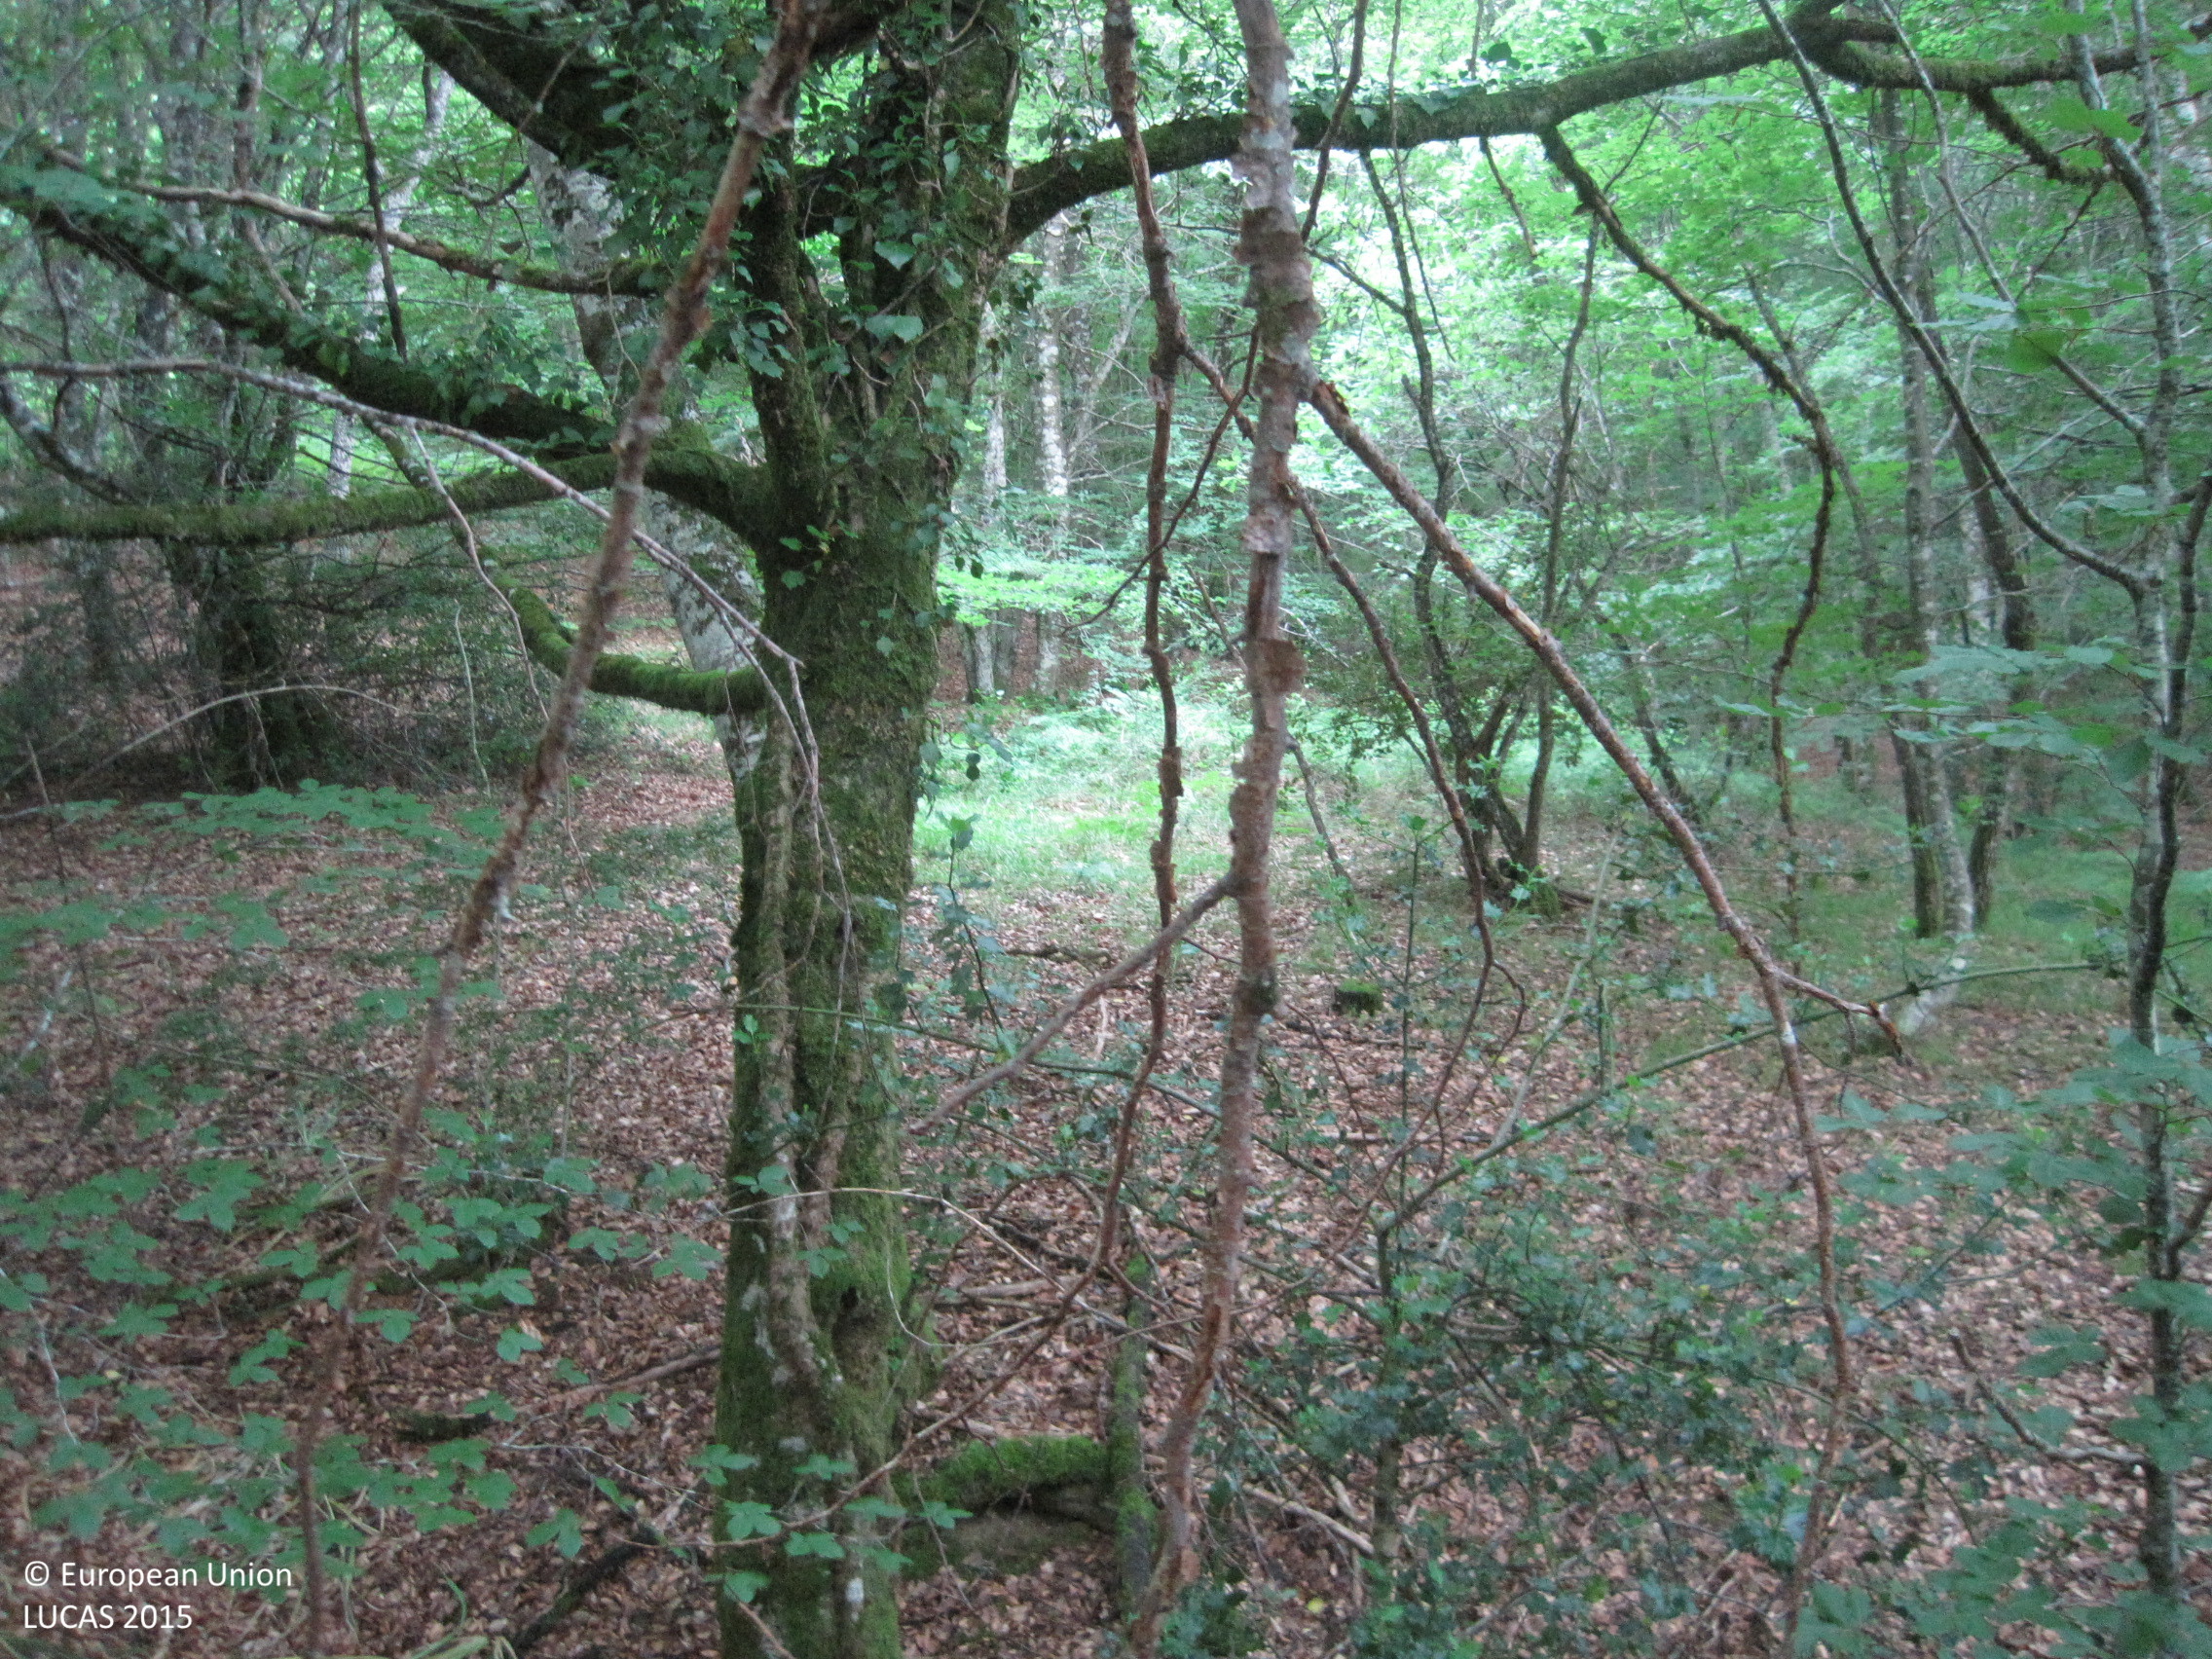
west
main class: Woodland
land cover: Broadleaved woodland
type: beech forest
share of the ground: > 75 %
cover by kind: broadleaved forest trees 100 %
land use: Forestry
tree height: > 5 m
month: June
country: ES
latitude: 43.0000
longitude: -1.8062
